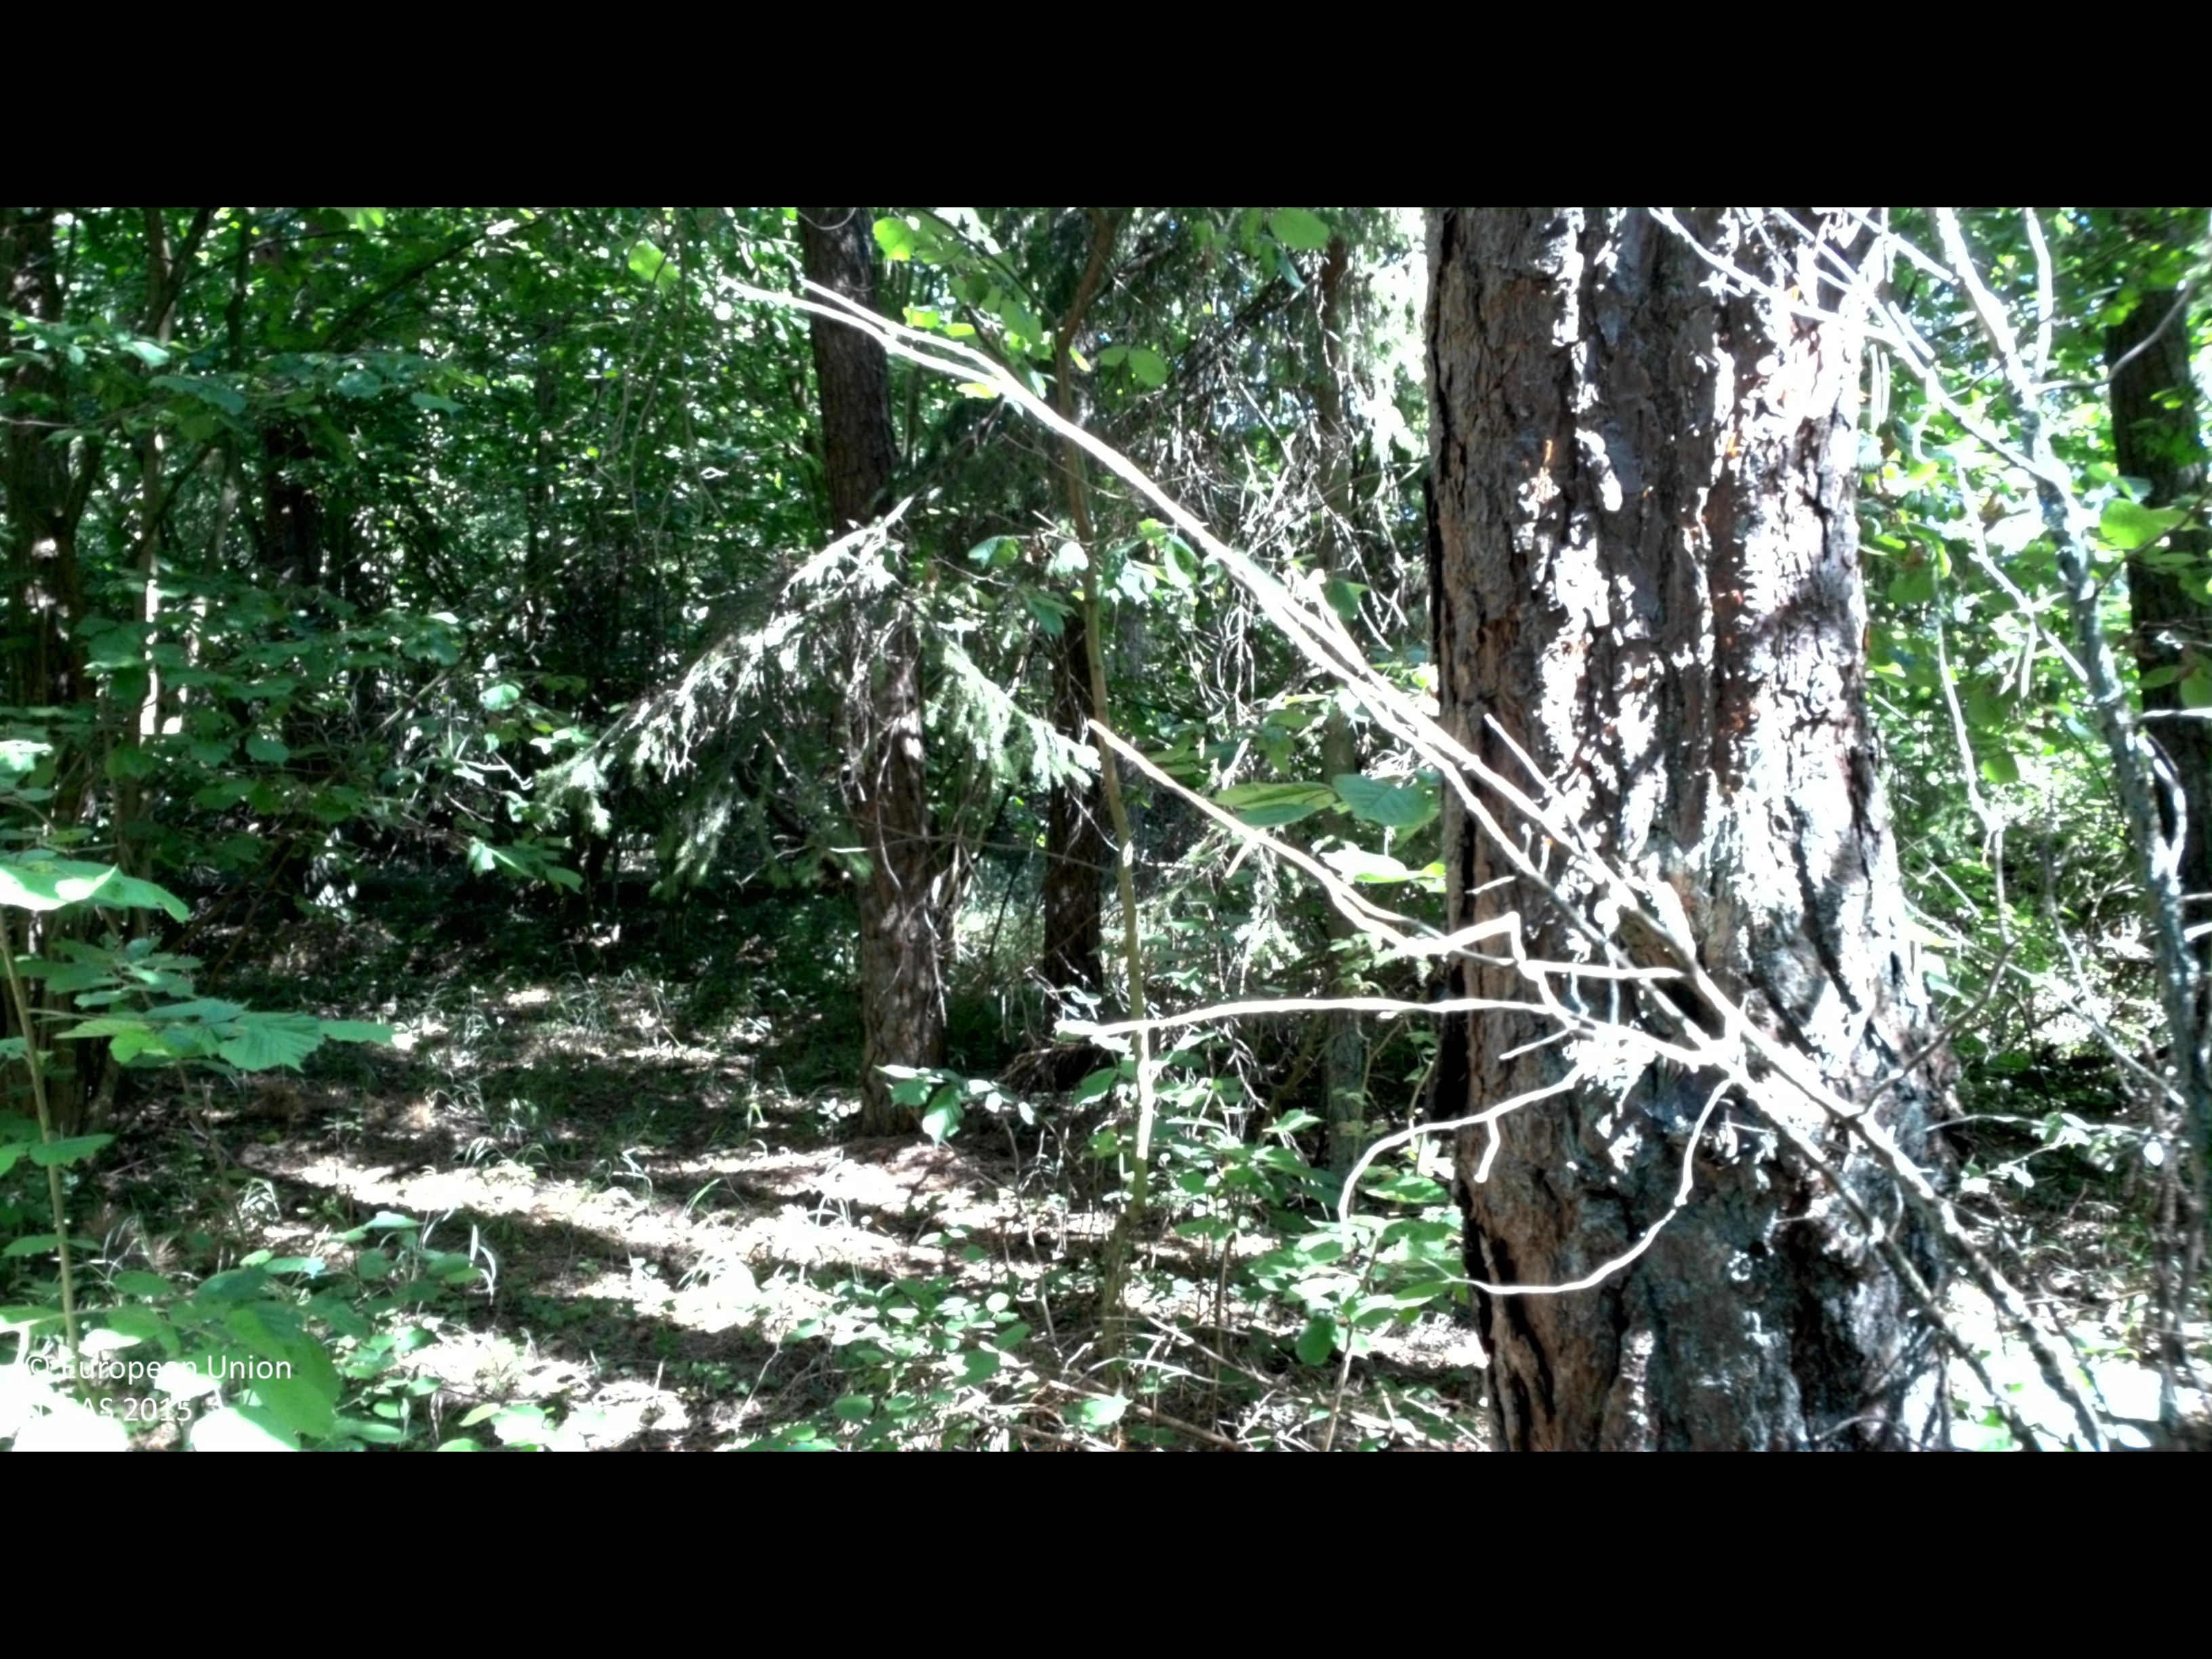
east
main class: Woodland
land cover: Pine dominated coniferous woodland
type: boreal forest
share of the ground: 50 - 75 %
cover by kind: coniferous forest trees 65 %, shrubs 30 %, herbaceous plants 5 %
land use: Forestry
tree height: > 5 m
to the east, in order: Pine dominated coniferous woodland; Dry stone walls; Fences; Shrubland without tree cover; Grassland with sparse tree/shrub cover; Shrubland with sparse tree cover; Grassland without tree/shrub cover; Shrubland with sparse tree cover; Grassland with sparse tree/shrub cover; Fences; Dry stone walls; Abandoned hedges; Grassland without tree/shrub cover
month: July
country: SE
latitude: 56.5954
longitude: 16.5978
